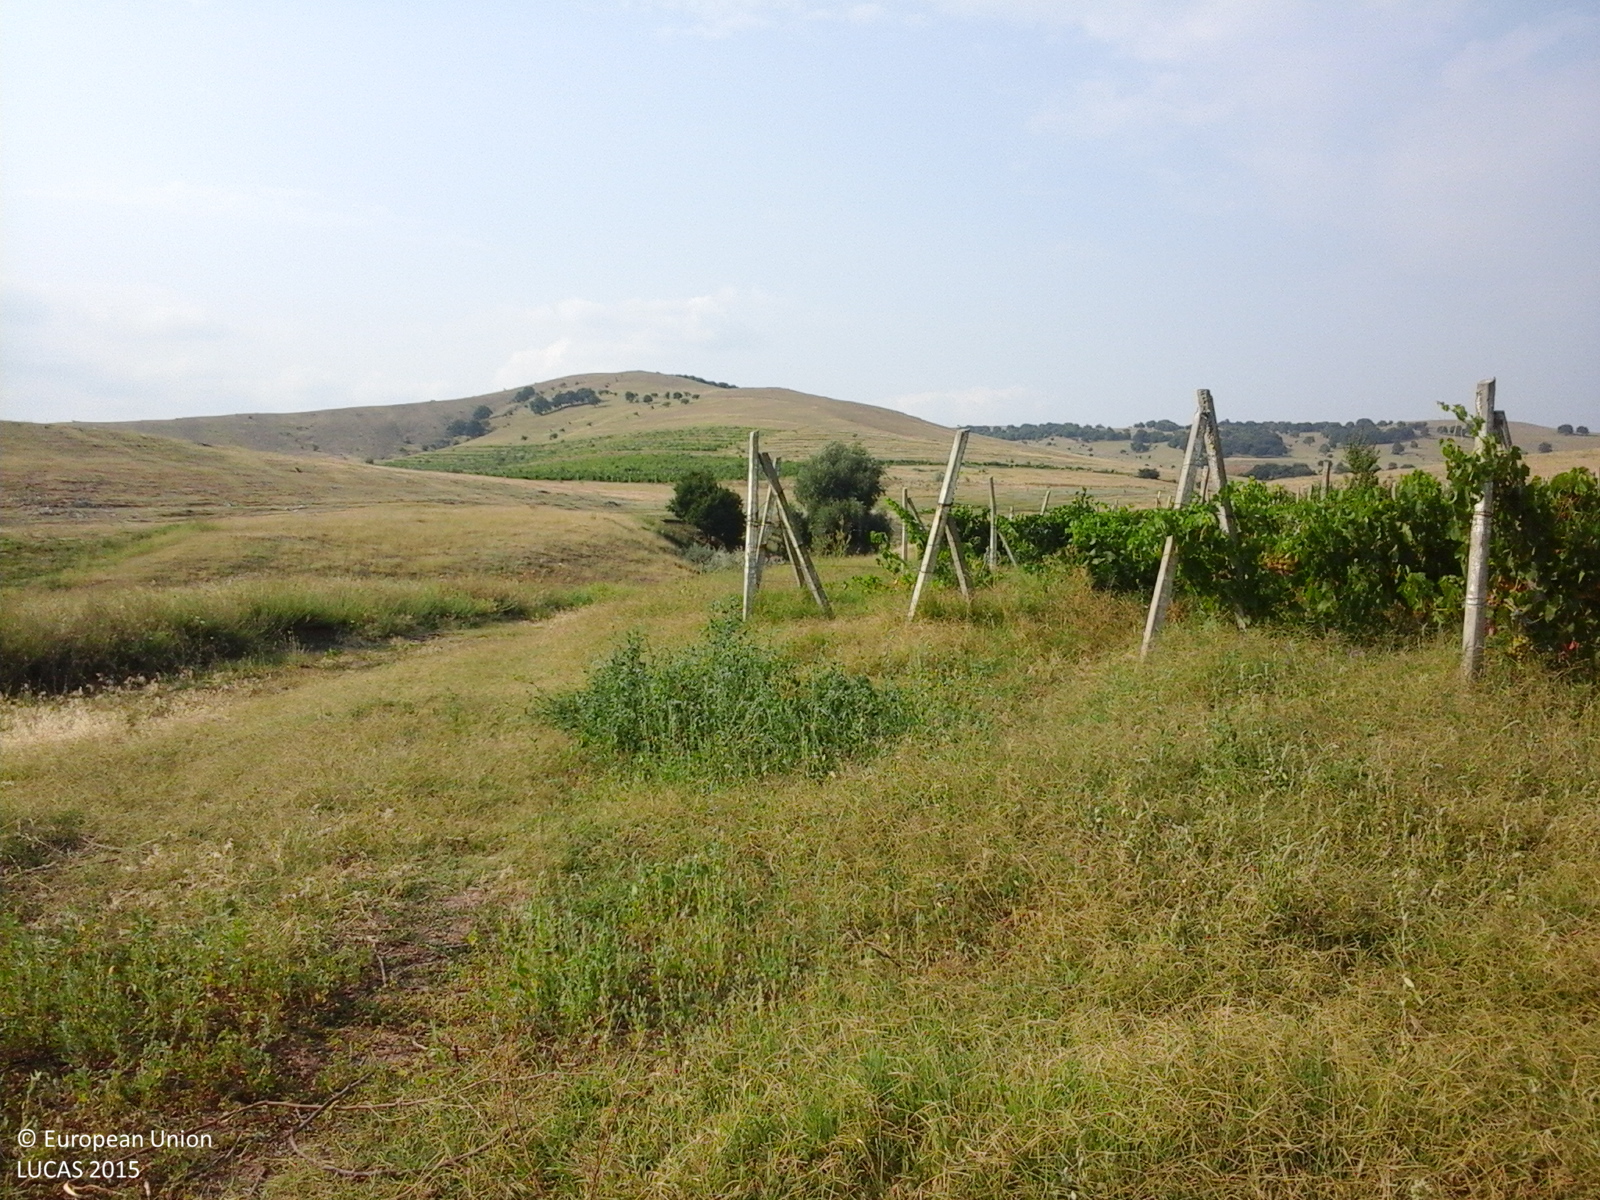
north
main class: Grassland
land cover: Grassland without tree/shrub cover
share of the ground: > 75 %
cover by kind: herbaceous plants 100 %
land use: Agriculture (excluding fallow land and kitchen gardens)
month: July
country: RO
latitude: 45.1080
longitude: 28.2852
